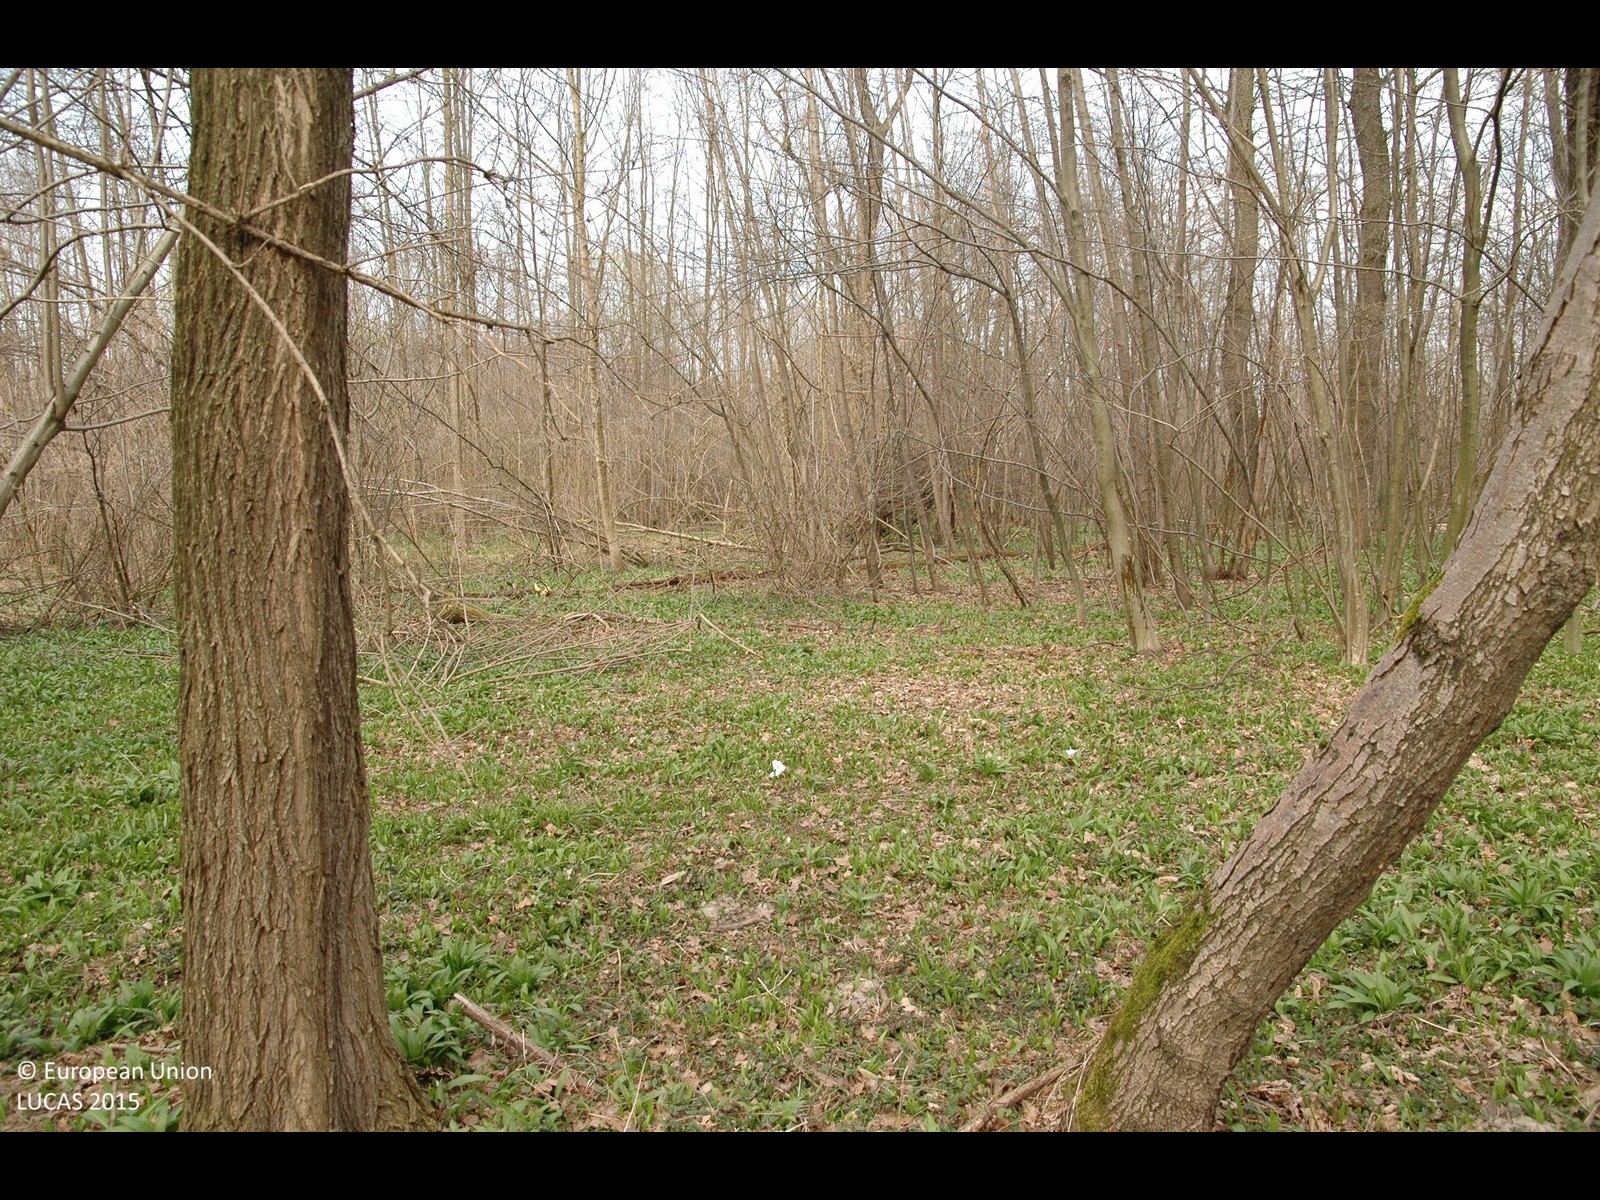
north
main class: Woodland
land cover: Broadleaved woodland
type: mesophytic deciduous forest
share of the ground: > 75 %
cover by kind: broadleaved forest trees 100 %
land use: Forestry
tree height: > 5 m
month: March
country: HR
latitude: 46.2829
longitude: 16.4508
